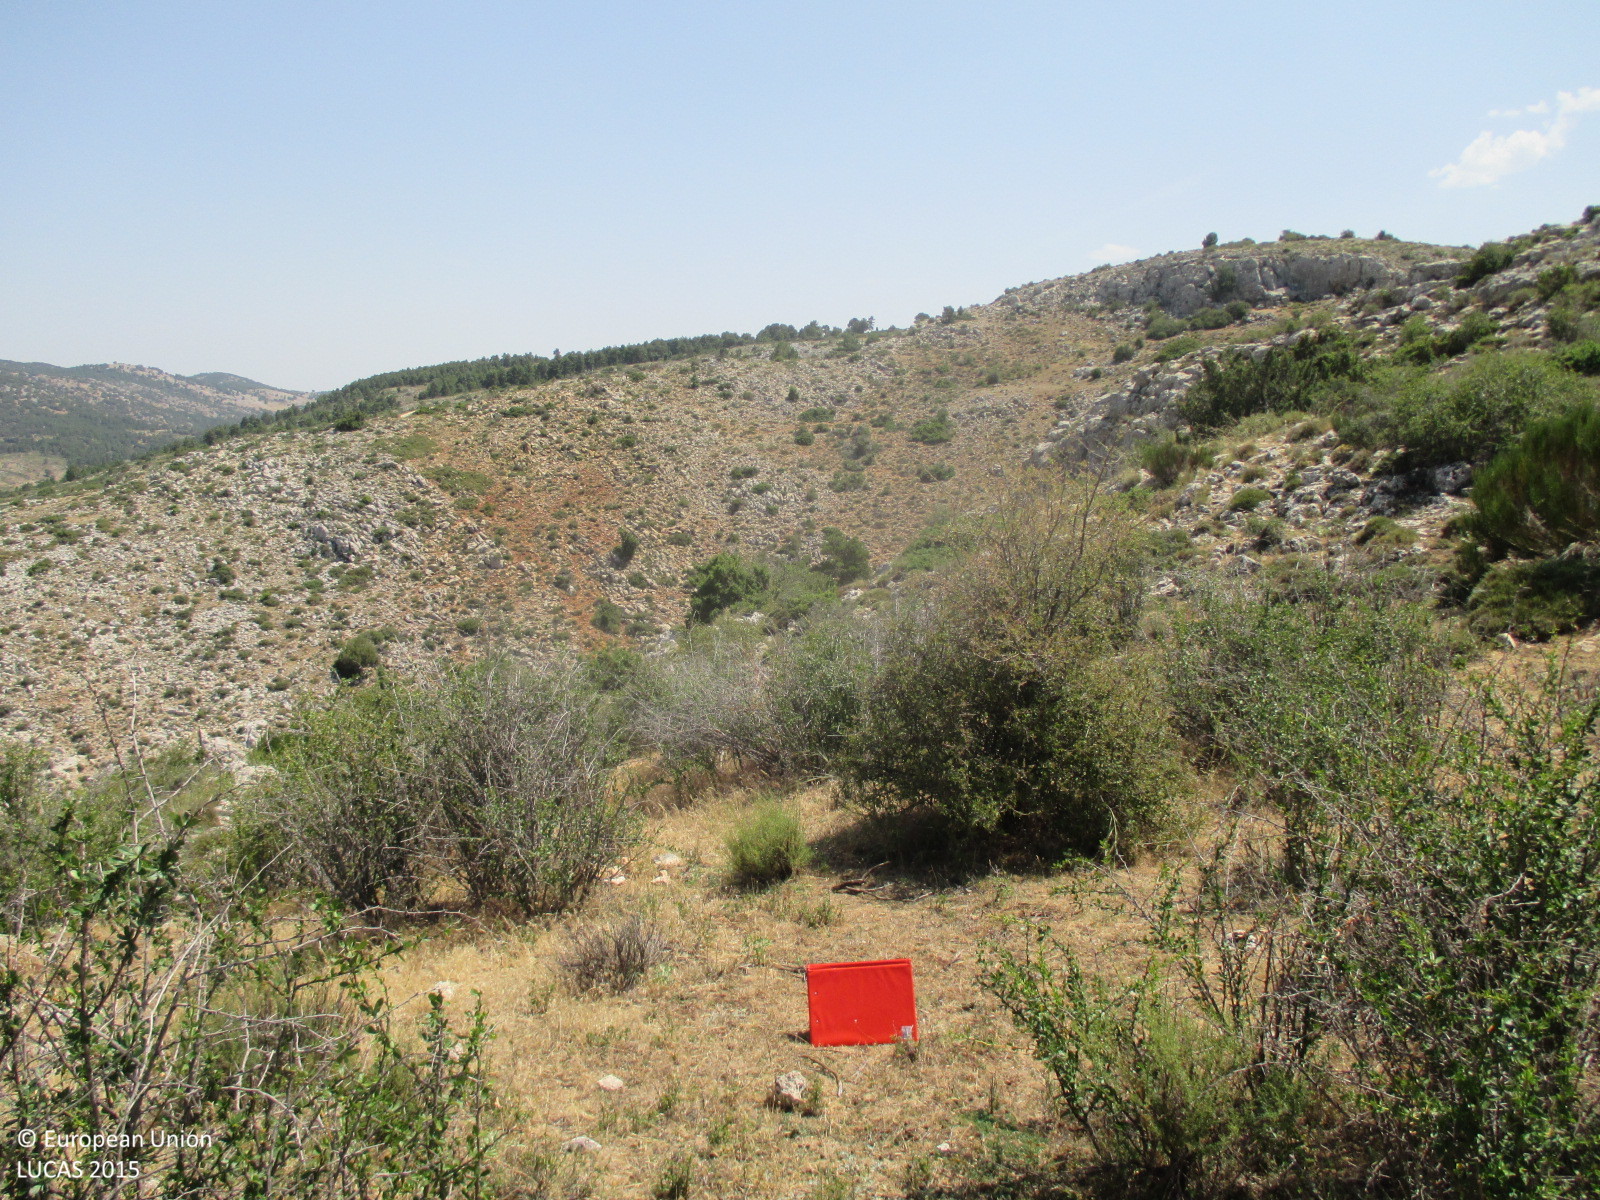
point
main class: Shrubland
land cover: Shrubland without tree cover
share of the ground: 50 - 75 %
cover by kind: shrubs 60 %, consolidated bare surface 30 %, herbaceous plants 10 %
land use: Semi-natural and natural areas not in use
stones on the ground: < 10 %
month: July
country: ES
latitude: 38.0947
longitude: -2.4793
